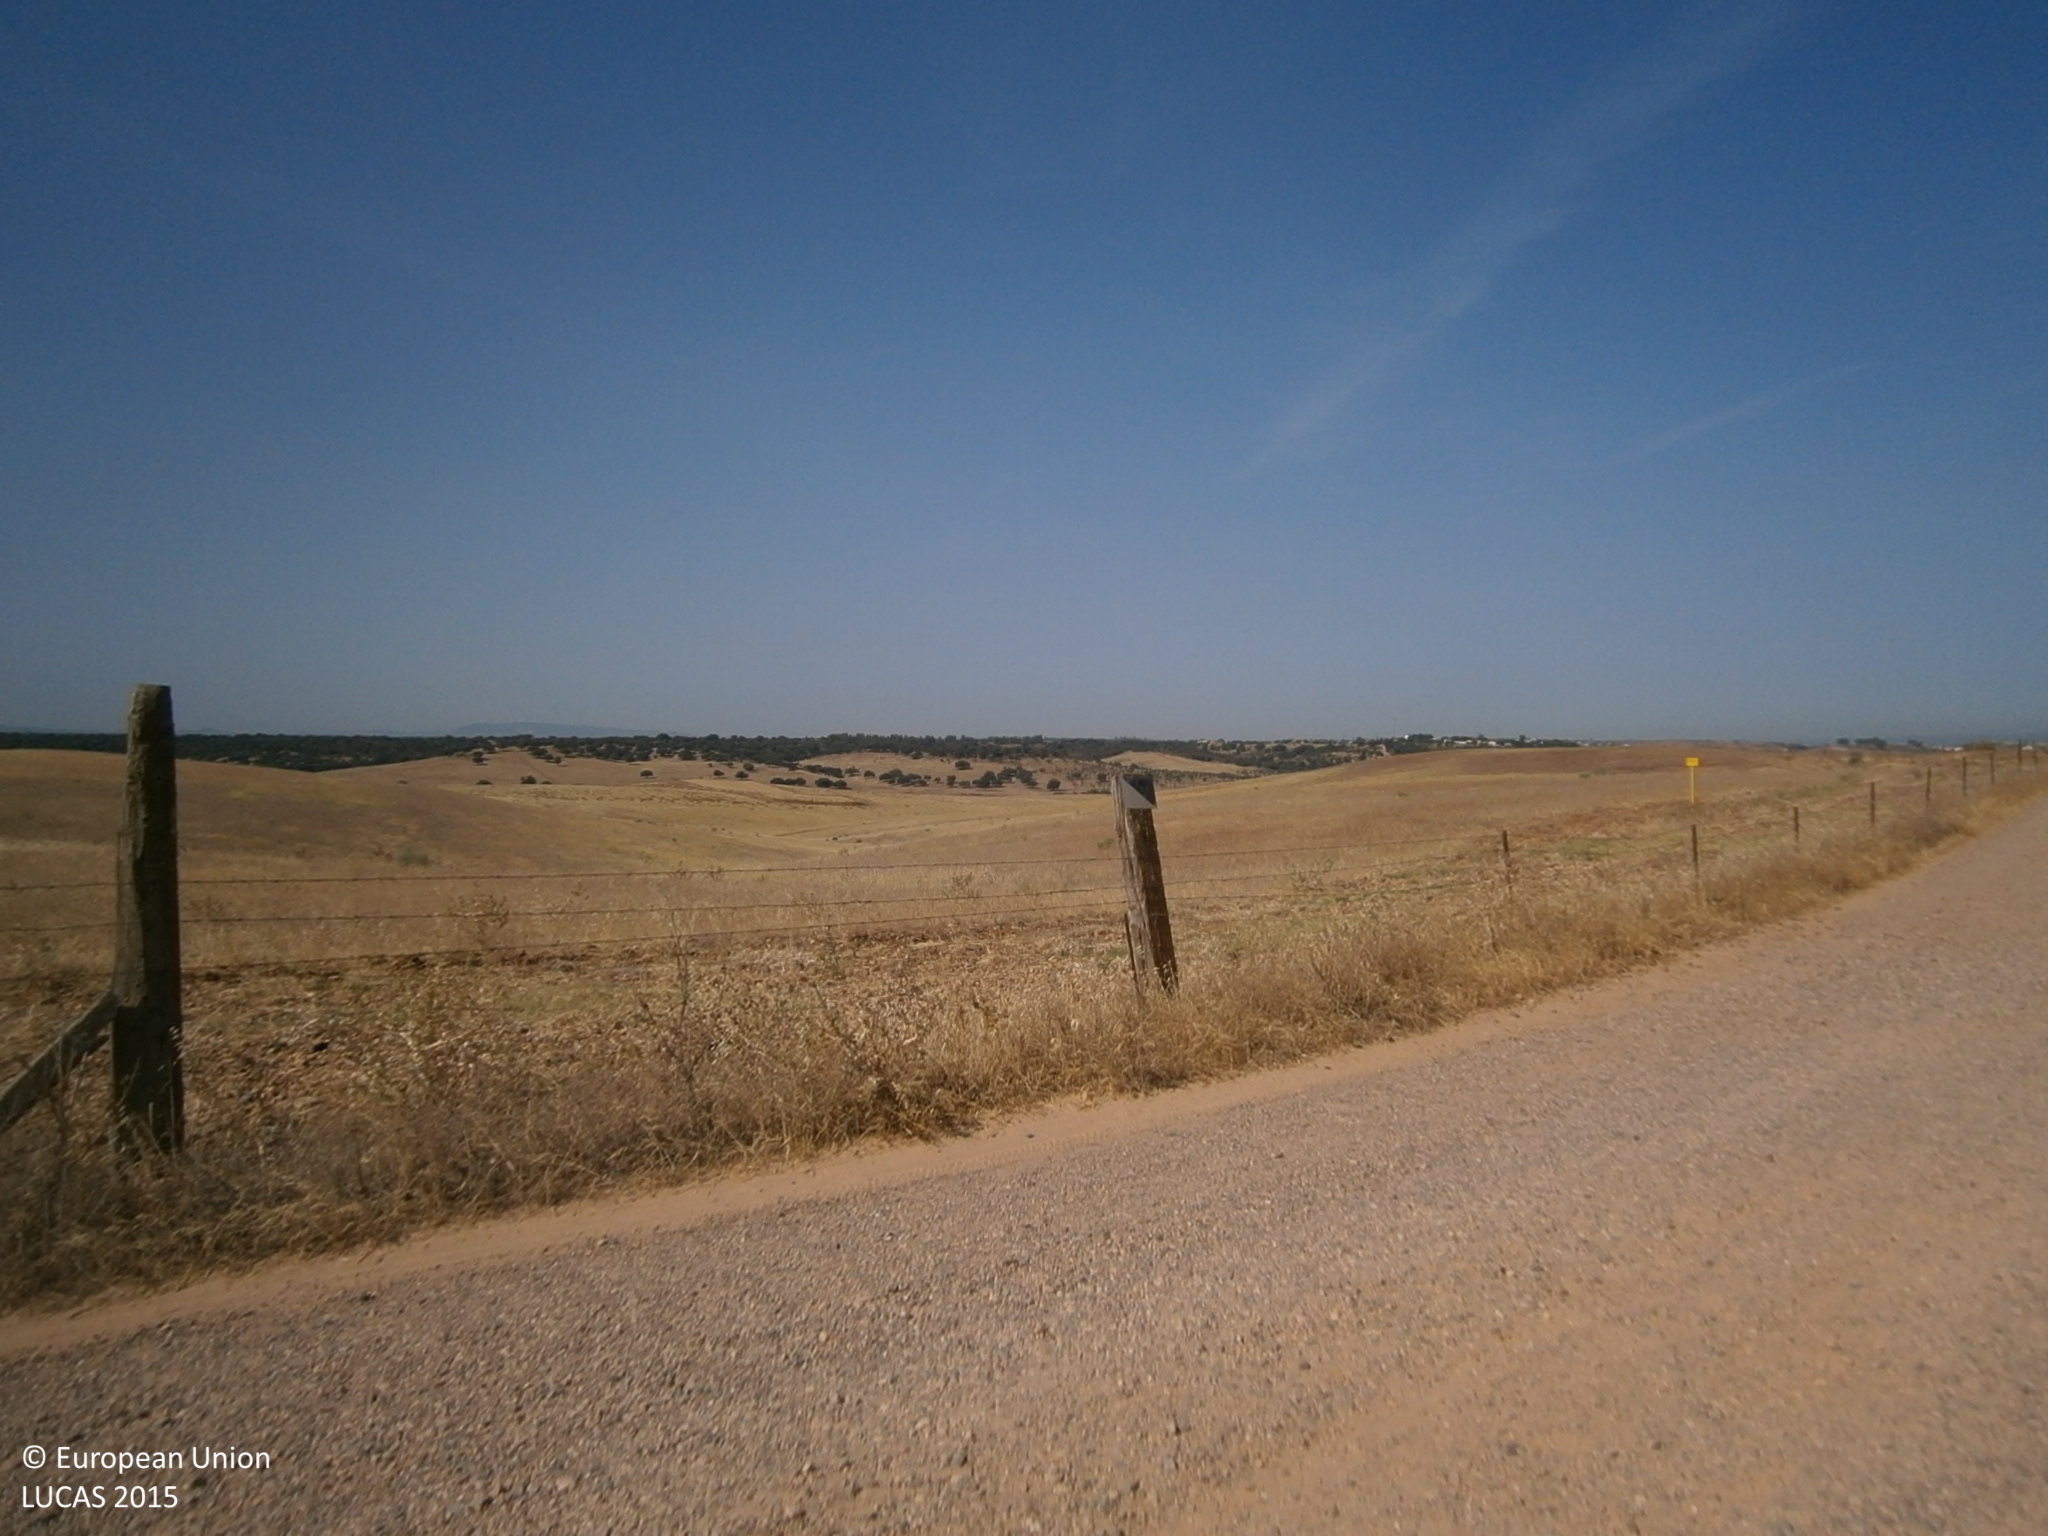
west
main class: Grassland
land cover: Grassland with sparse tree/shrub cover
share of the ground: > 75 %
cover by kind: herbaceous plants 70 %, shrubs 10 %, unconsolidated bare surface 10 %, broadleaved forest trees 5 %
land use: Agriculture (excluding fallow land and kitchen gardens)
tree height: > 5 m
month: July
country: ES
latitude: 38.8797
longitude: -6.9098
